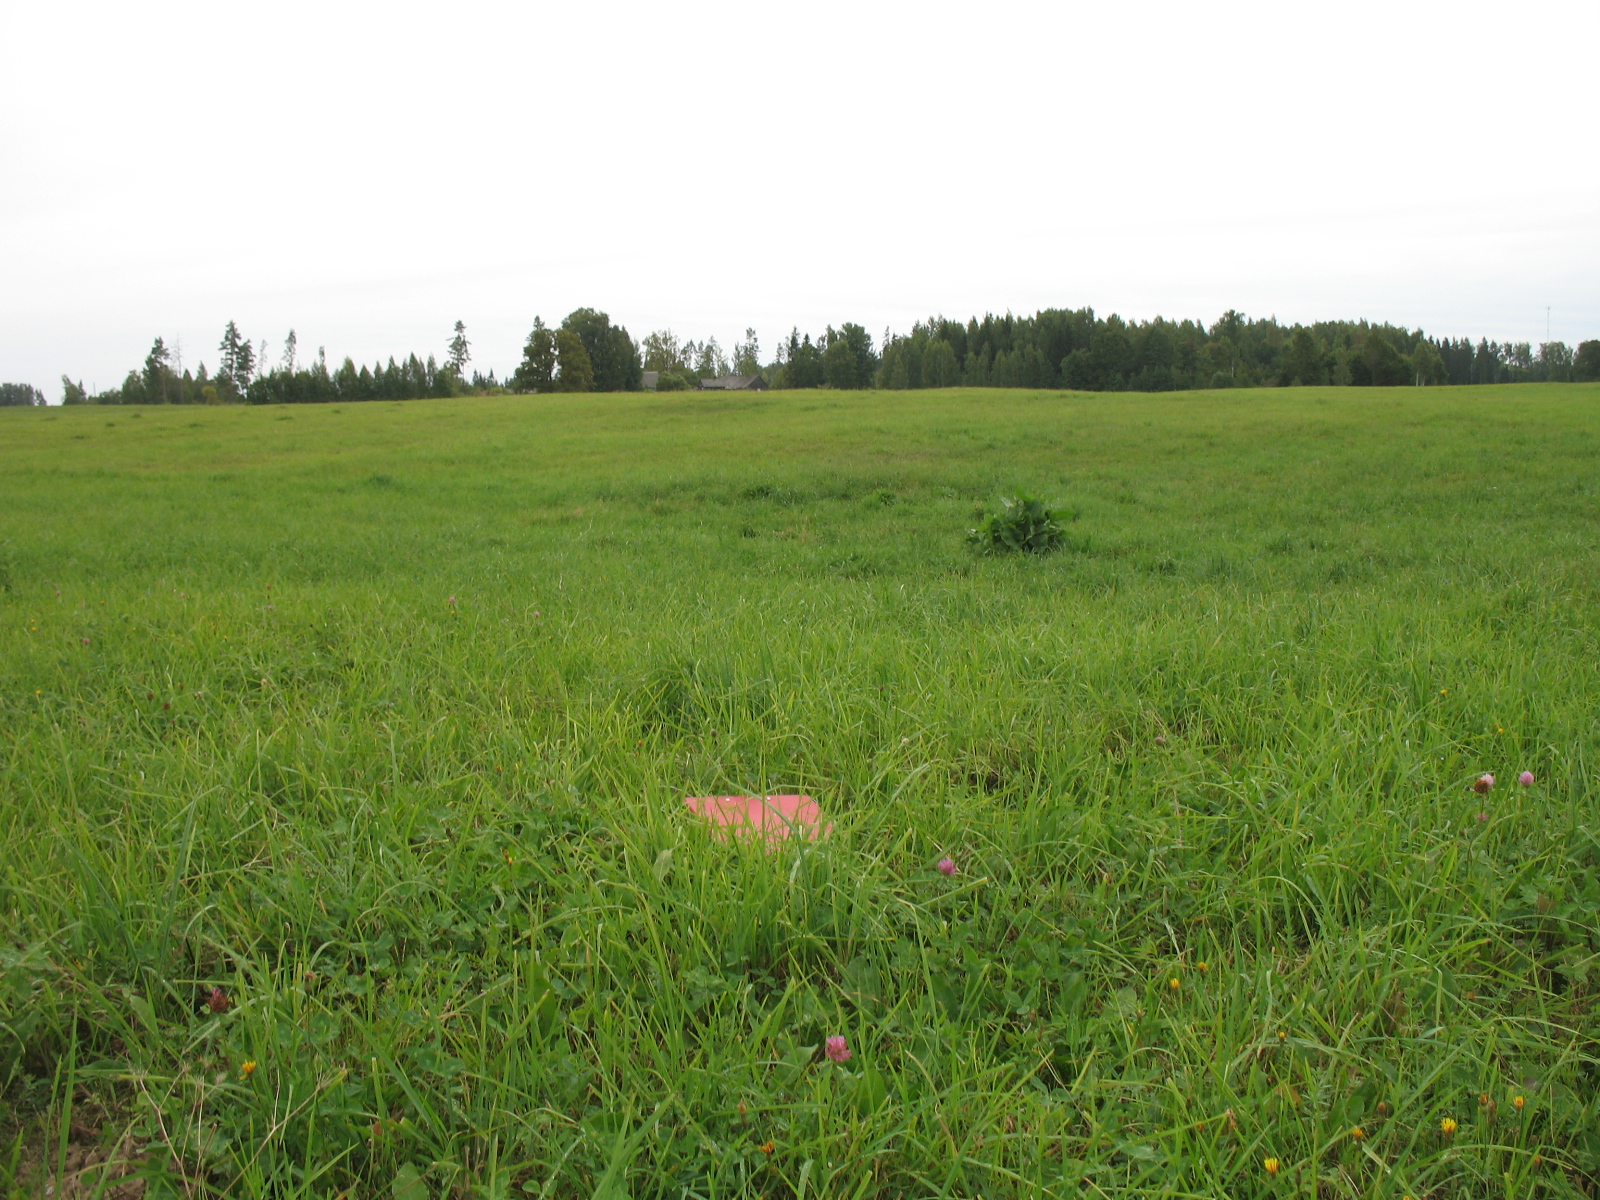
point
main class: Grassland
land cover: Grassland without tree/shrub cover
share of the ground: > 75 %
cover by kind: herbaceous plants 100 %
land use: Agriculture (excluding fallow land and kitchen gardens)
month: September
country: LV
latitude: 56.1990
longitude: 26.1771
